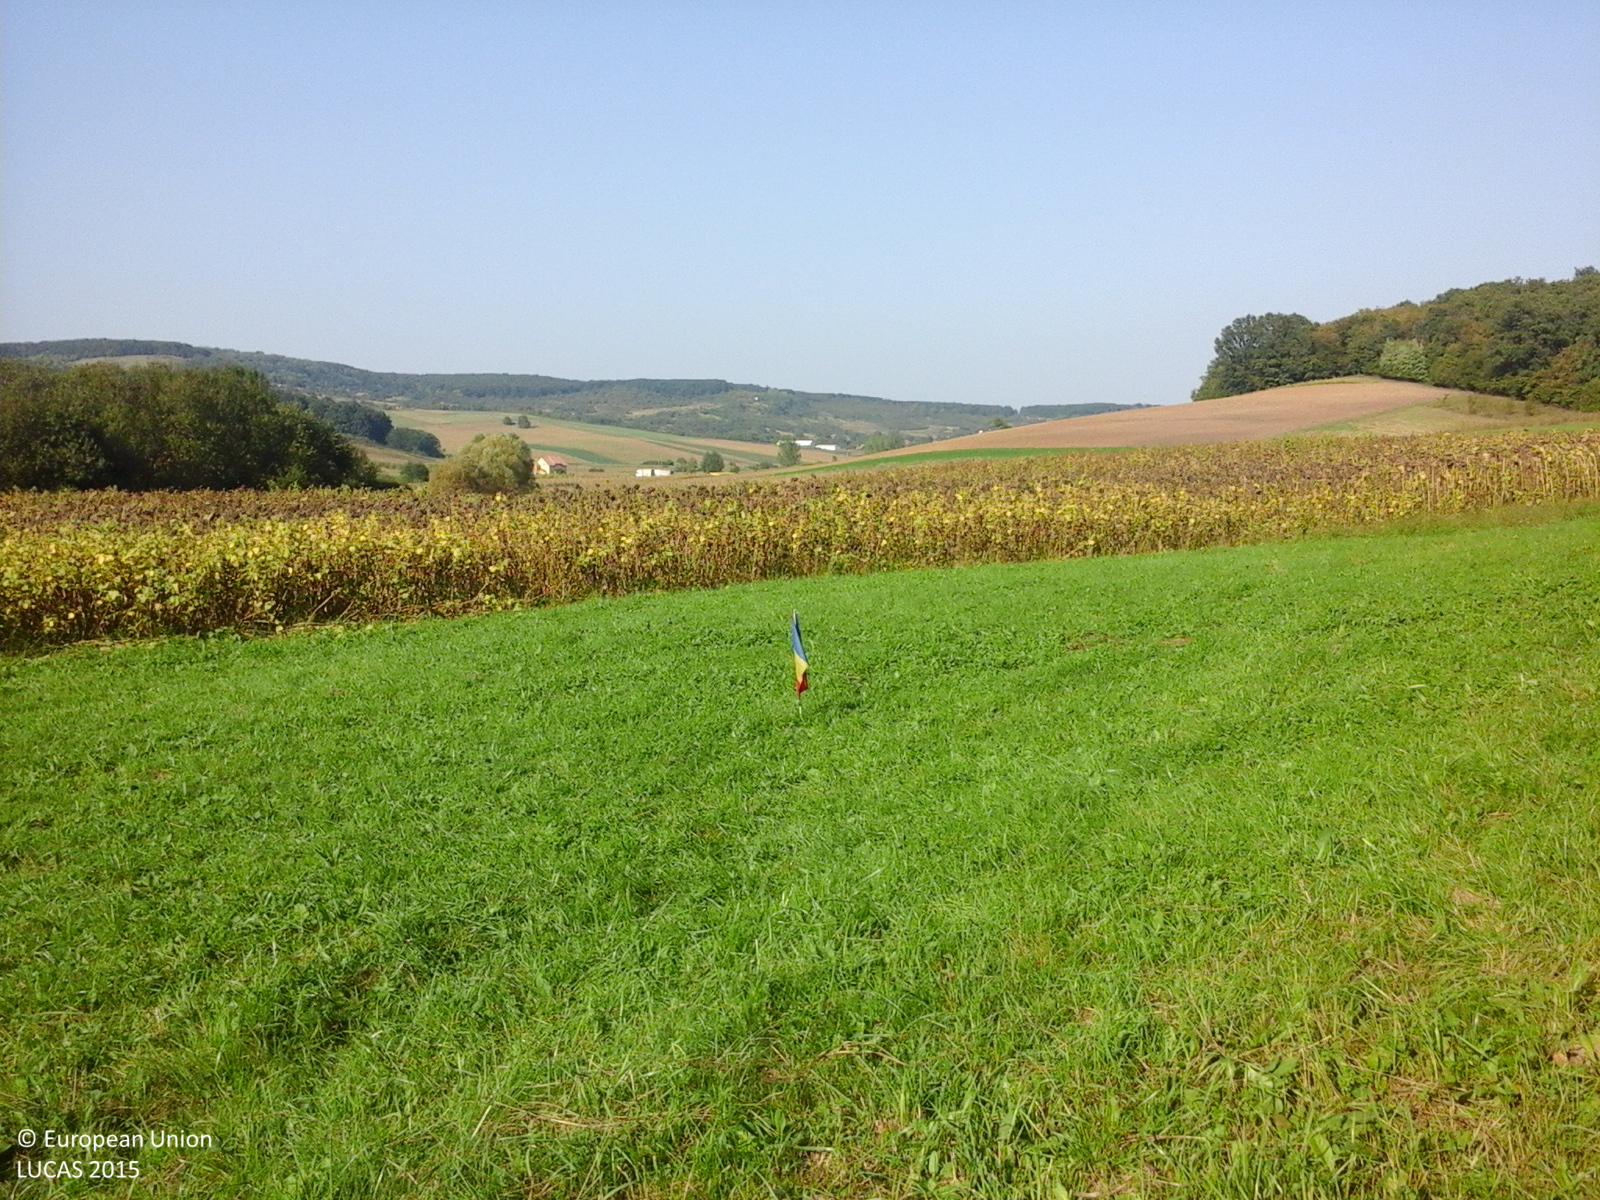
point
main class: Grassland
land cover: Grassland without tree/shrub cover
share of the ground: > 75 %
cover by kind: herbaceous plants 100 %
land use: Agriculture (excluding fallow land and kitchen gardens)
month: September
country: RO
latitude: 47.2629
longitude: 22.7335
